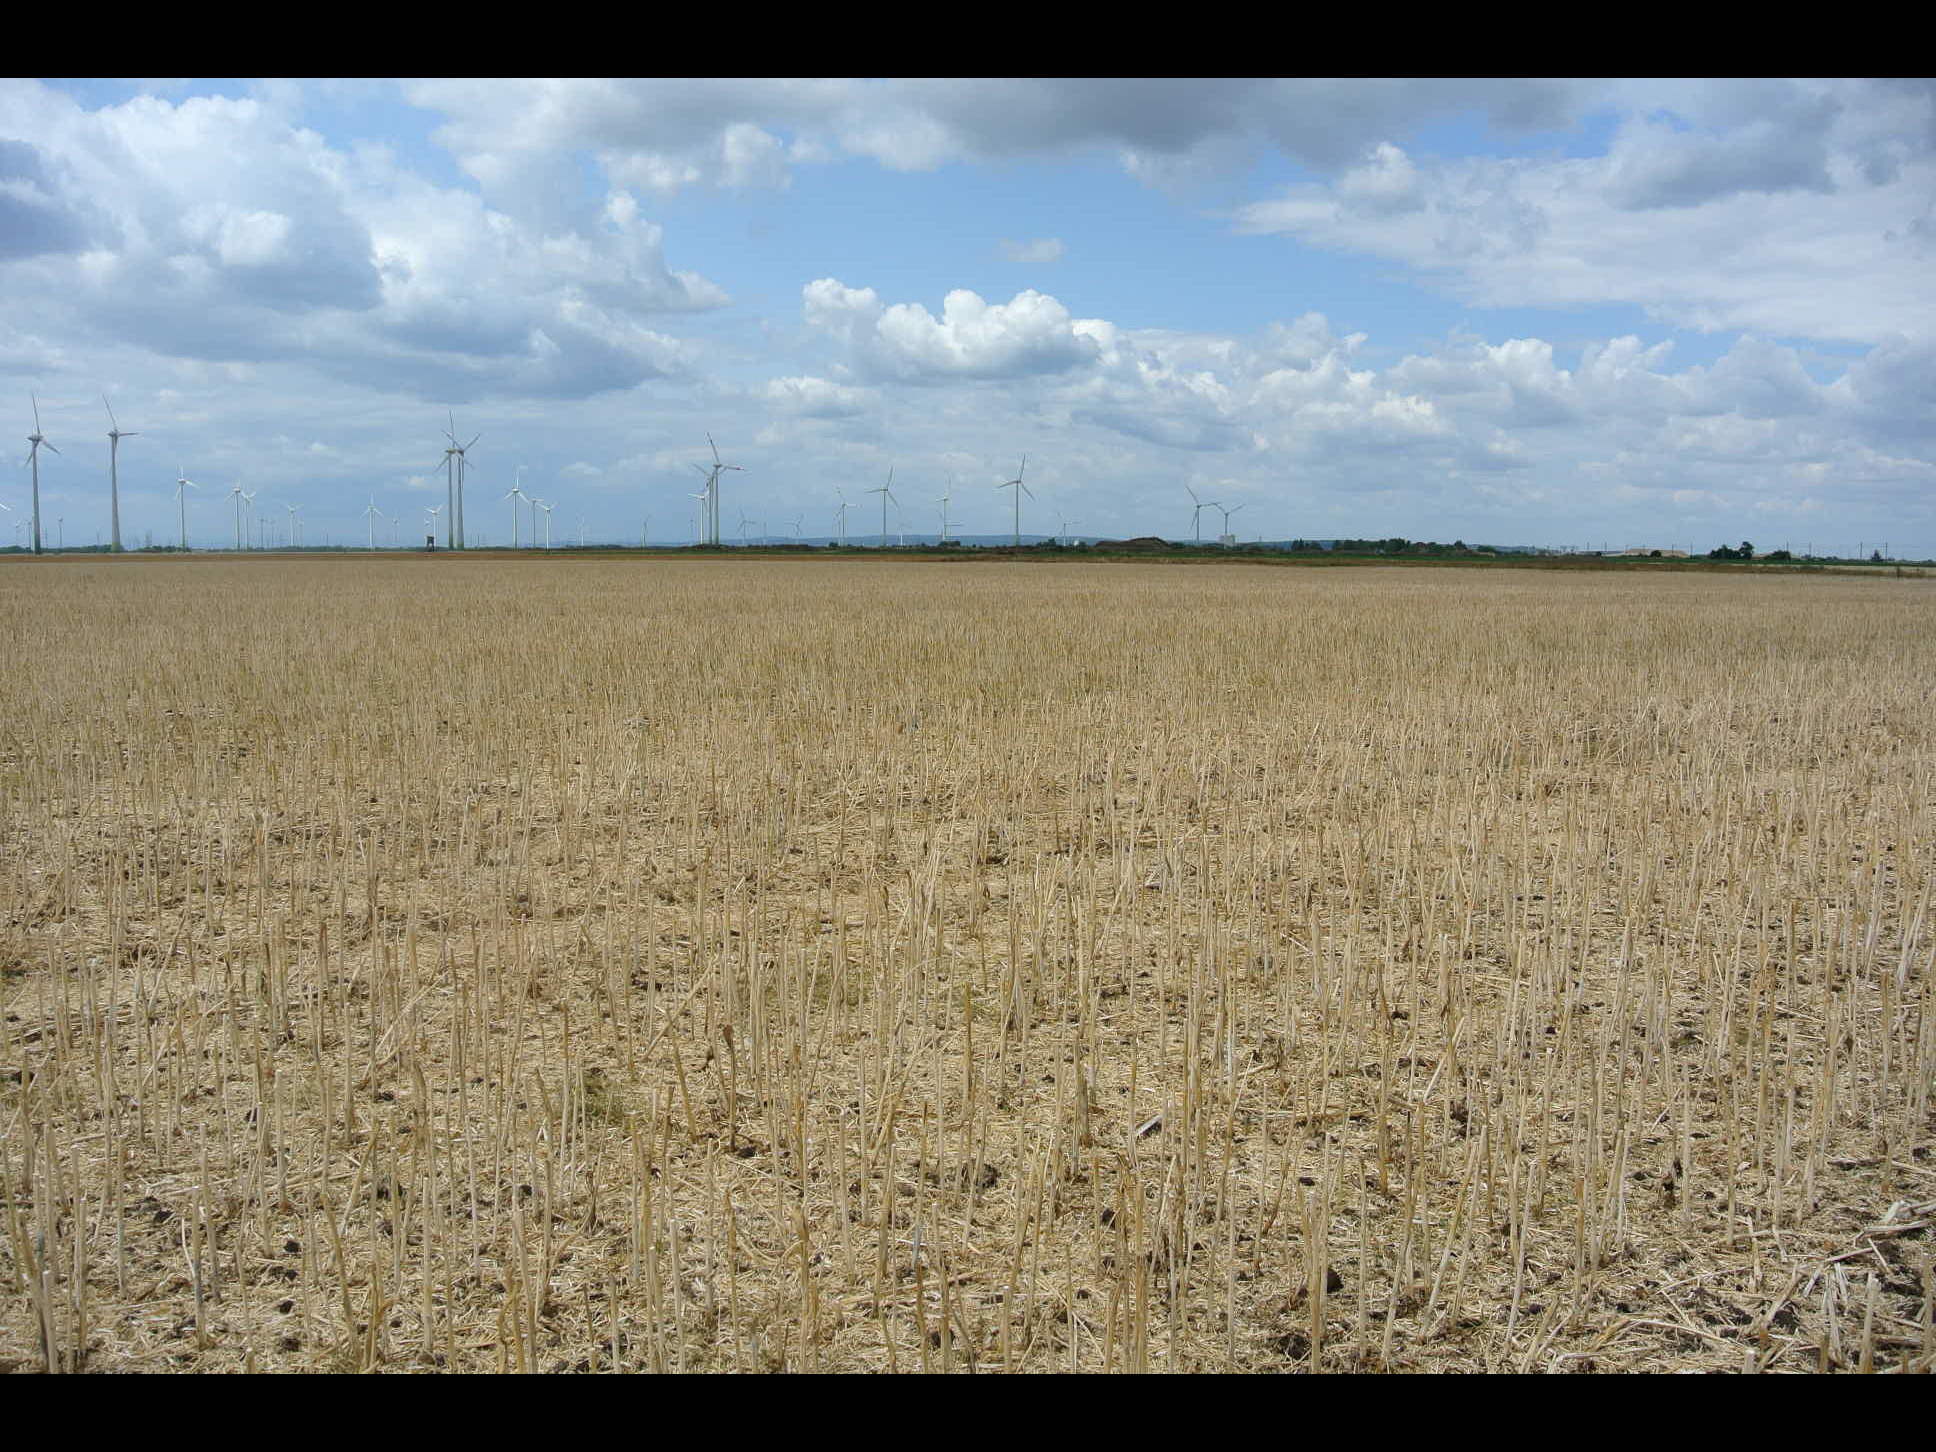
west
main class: Cropland
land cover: Rape and turnip rape
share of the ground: > 75 %
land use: Agriculture (excluding fallow land and kitchen gardens)
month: July
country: AT
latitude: 47.9871
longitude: 16.9341
